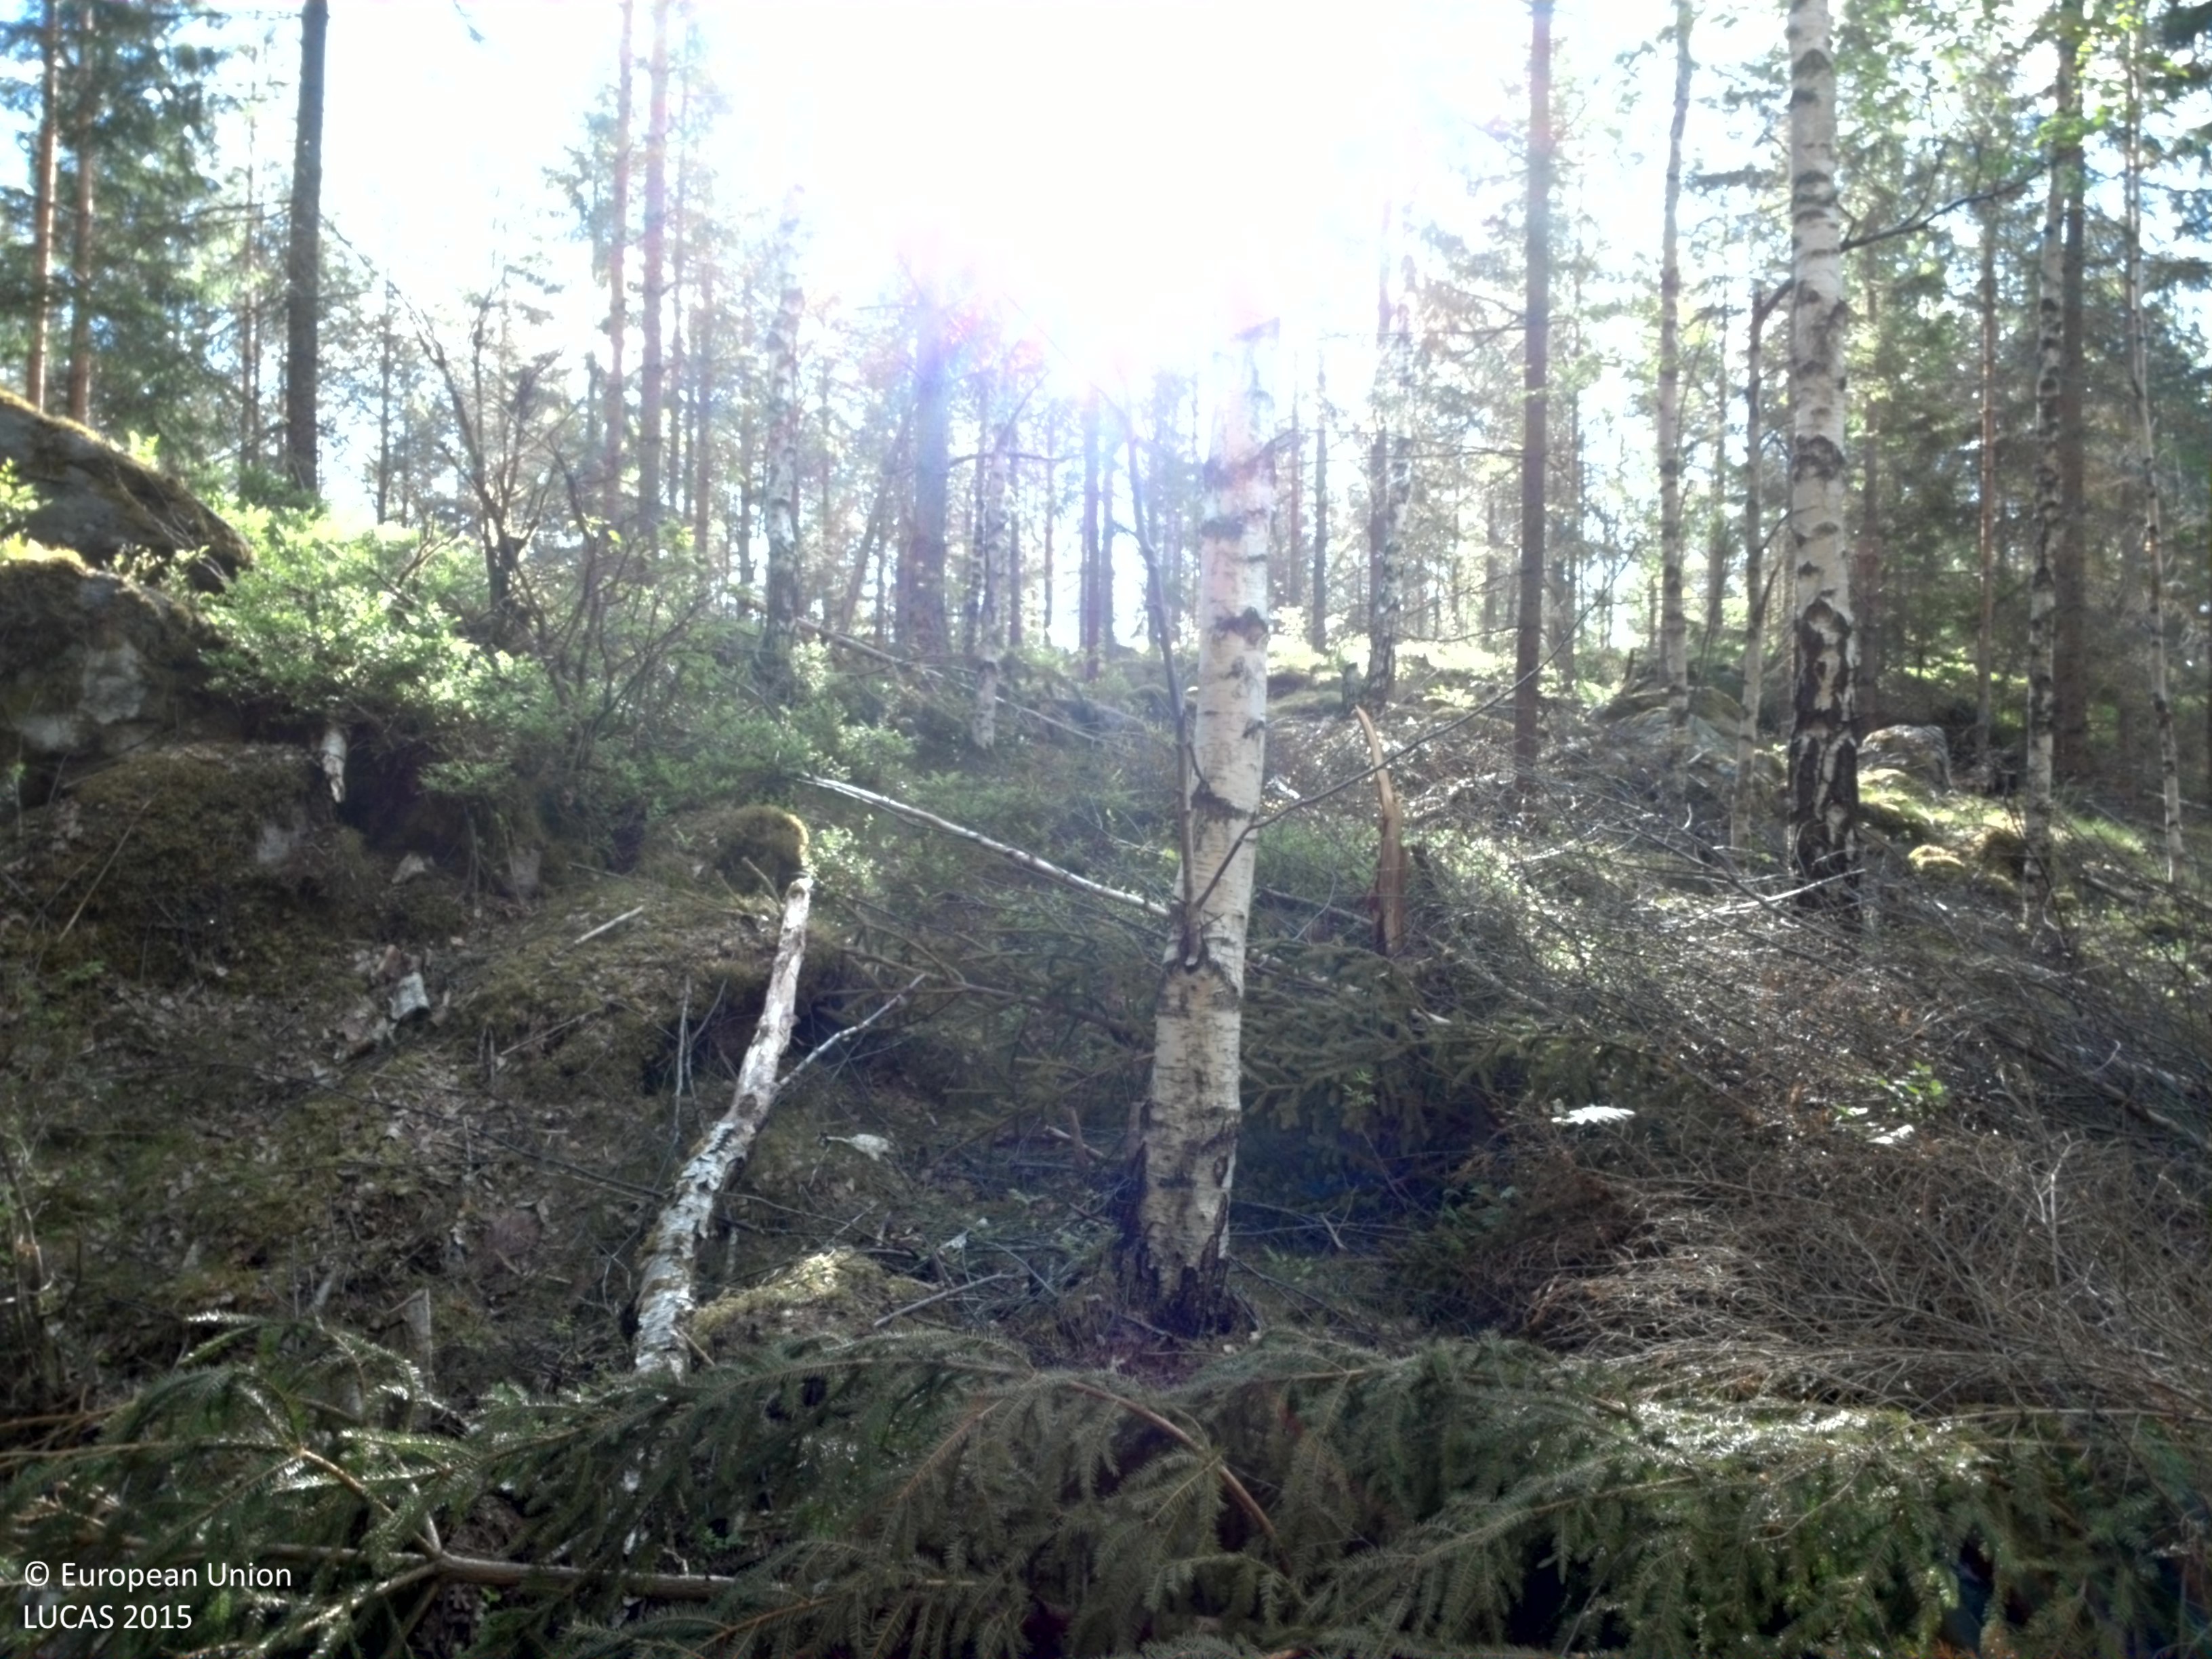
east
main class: Woodland
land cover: Other mixed woodland
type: boreal forest
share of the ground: > 75 %
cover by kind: coniferous forest trees 45 %, broadleaved forest trees 35 %, shrubs 10 %, herbaceous plants 10 %
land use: Forestry
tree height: > 5 m
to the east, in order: Other mixed woodland; Tracks; Other mixed woodland; Pine dominated coniferous woodland; Tracks; Pine dominated coniferous woodland; Pine dominated mixed woodland; Tracks; Pine dominated coniferous woodland; Spruce dominated coniferous woodland; Ditches and canals; Spruce dominated mixed woodland; Ditches and canals; Spruce dominated mixed woodland; Spruce dominated coniferous woodland
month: June
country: SE
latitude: 58.6513
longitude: 14.4221
